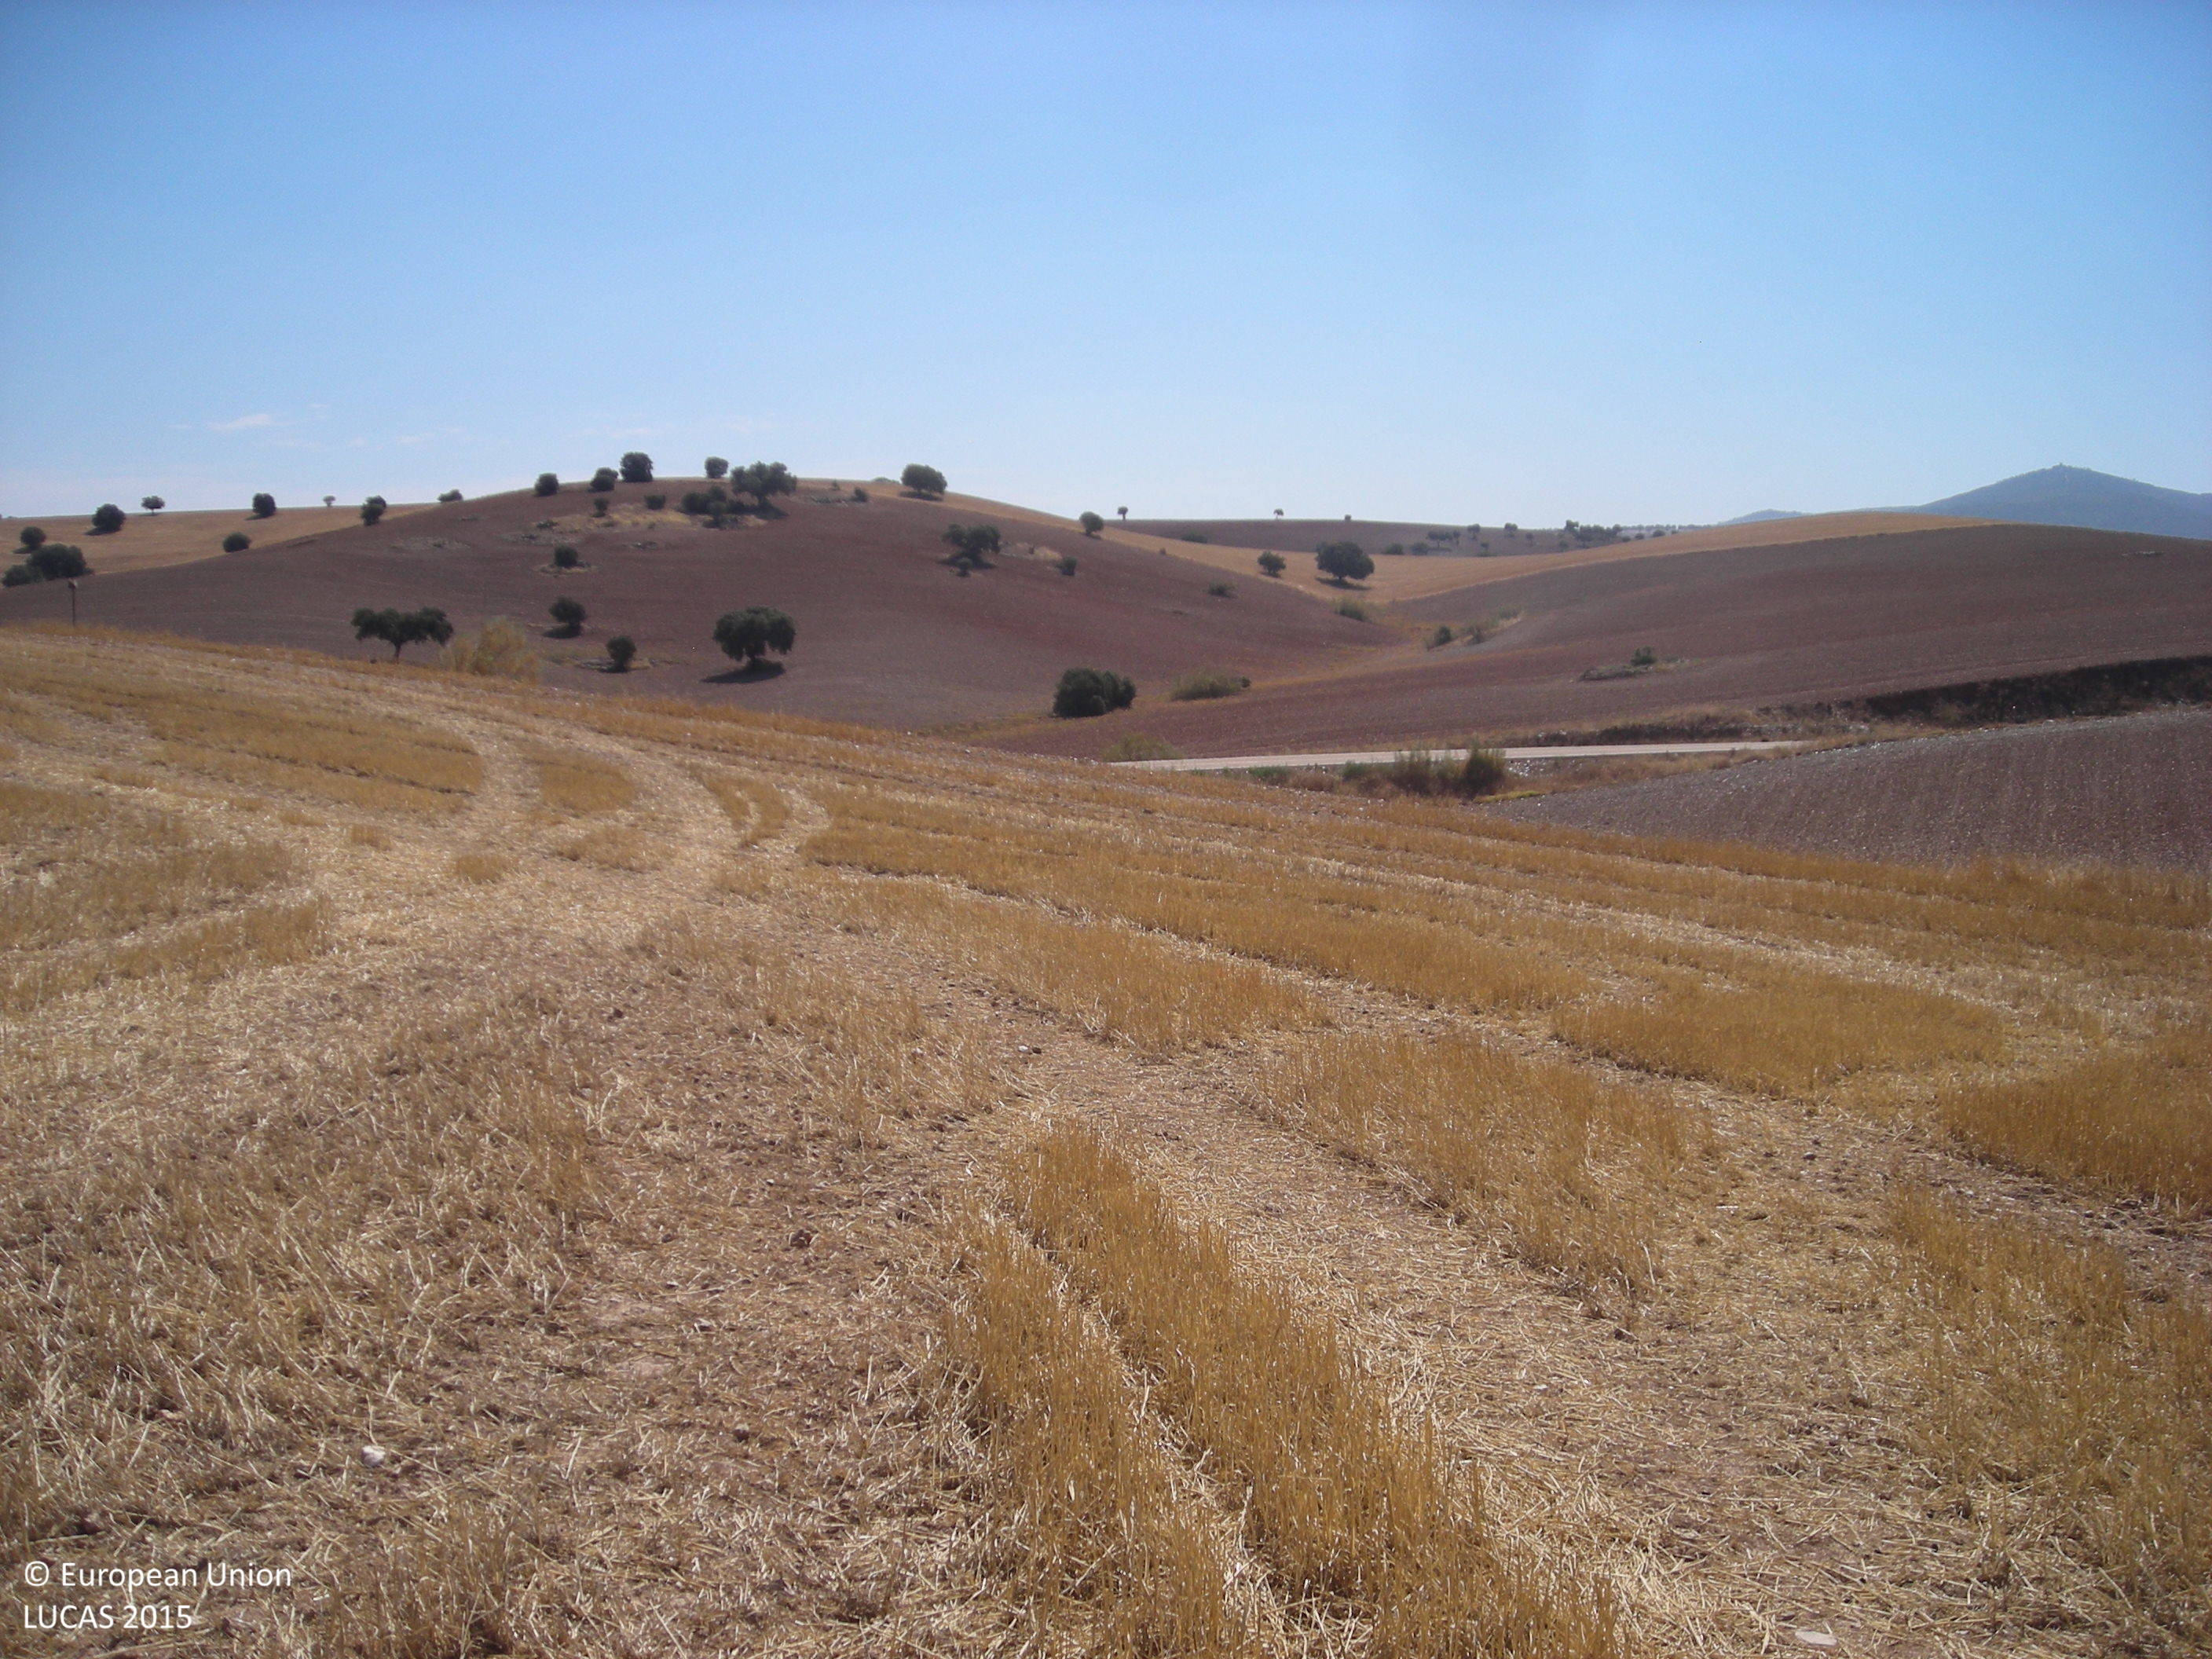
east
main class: Cropland
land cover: Common wheat
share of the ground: > 75 %
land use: Agriculture (excluding fallow land and kitchen gardens)
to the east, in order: Common wheat; Grass margins; Other bare soil; Grassland with sparse tree/shrub cover; Paved roads, cycling and walking lanes; Grassland with sparse tree/shrub cover; Other bare soil
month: July
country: ES
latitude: 38.8308
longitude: -5.9102
